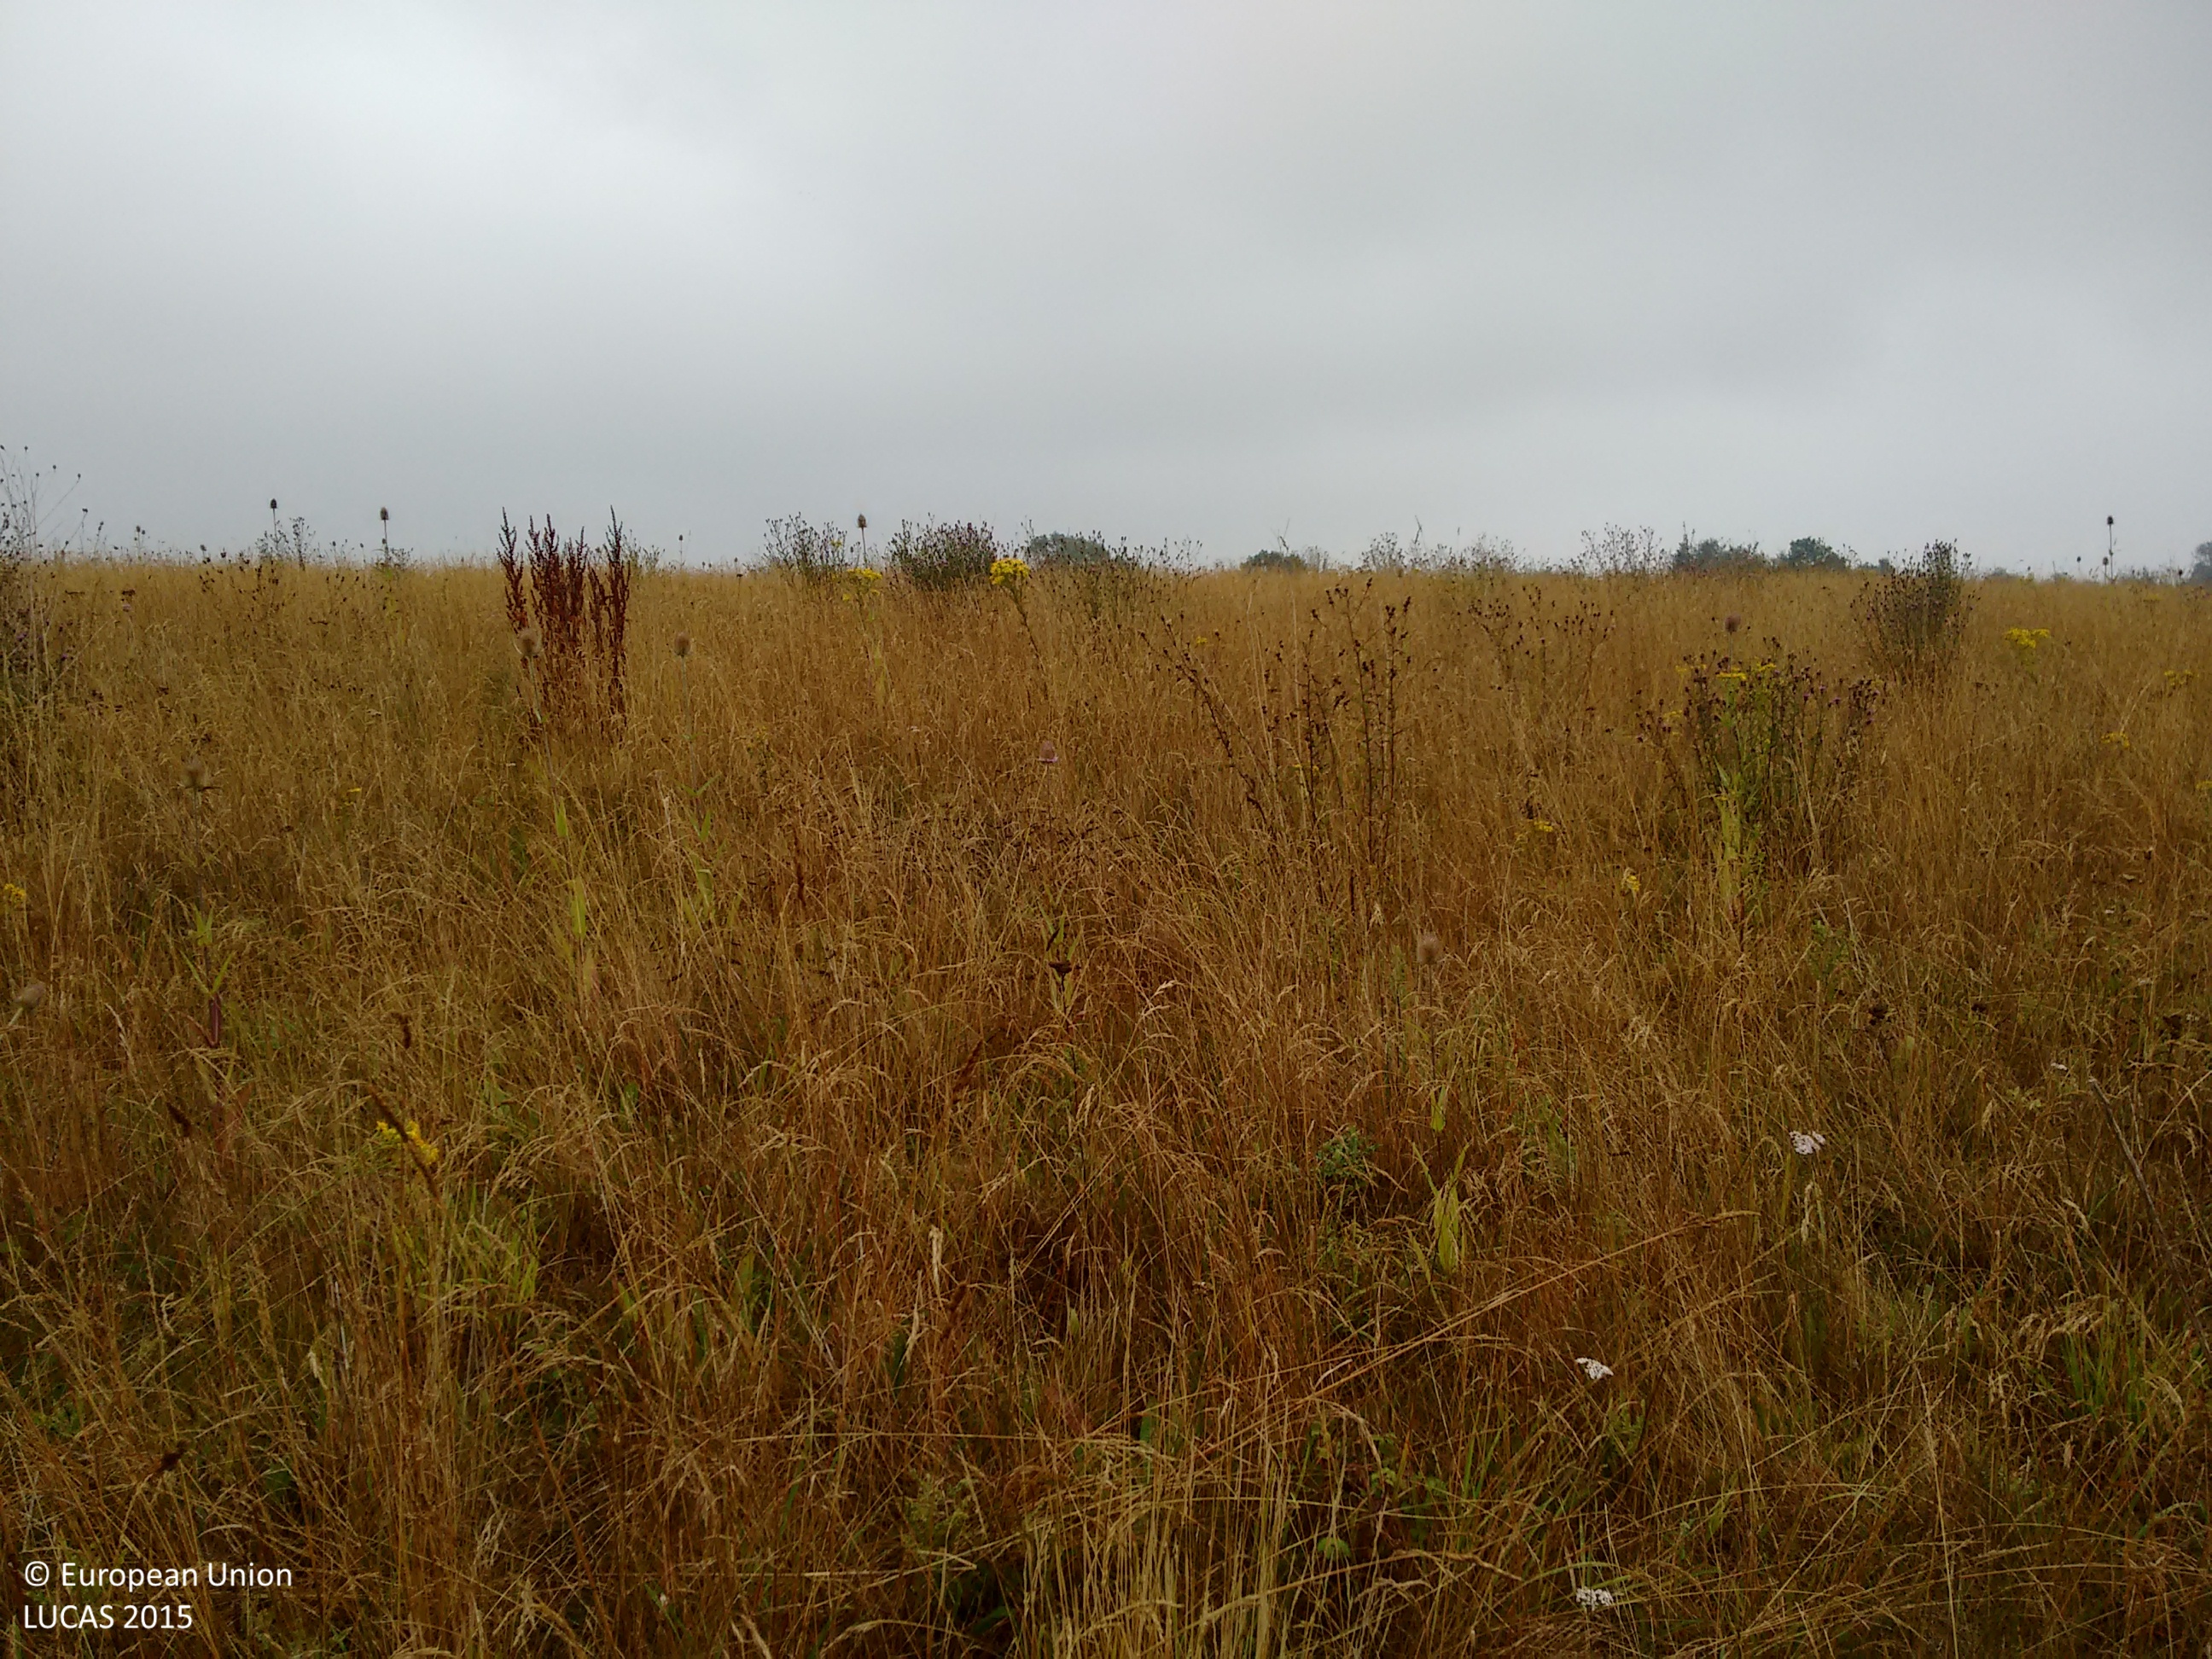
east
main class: Grassland
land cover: Grassland without tree/shrub cover
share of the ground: > 75 %
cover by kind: herbaceous plants 100 %
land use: Agriculture (excluding fallow land and kitchen gardens)
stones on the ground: 10 - 25 %
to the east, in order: Grassland without tree/shrub cover; Barley
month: August
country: GB
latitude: 51.9669
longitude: 1.0549
